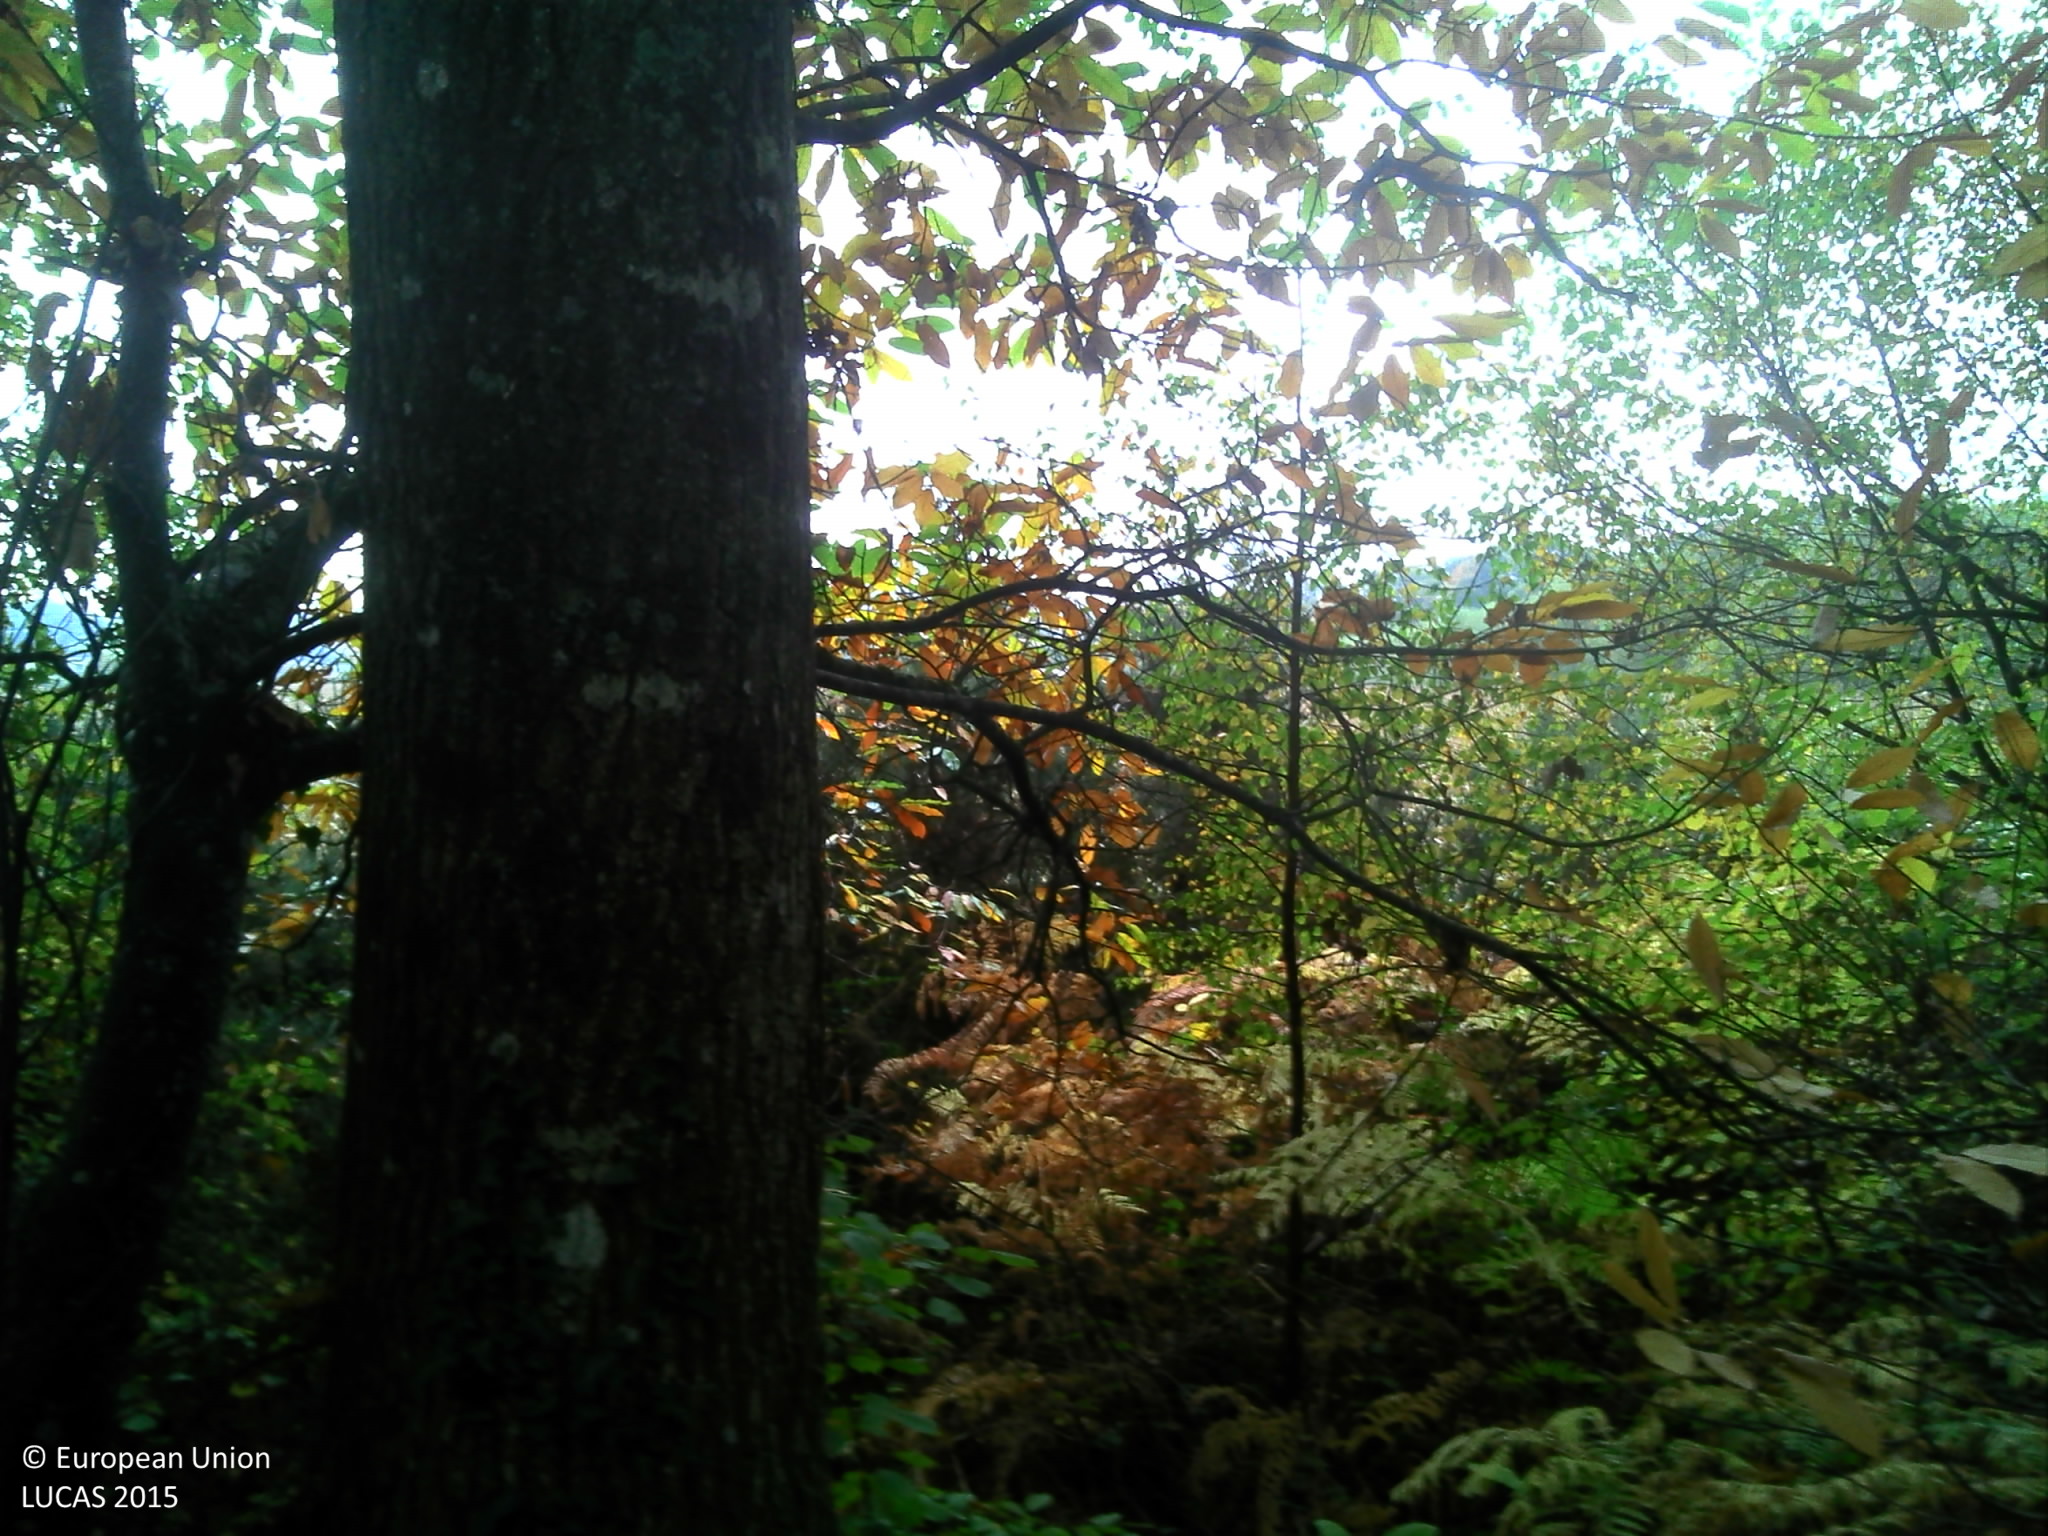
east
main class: Woodland
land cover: Broadleaved woodland
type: acidophilous oak and oak-birch forest
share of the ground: > 75 %
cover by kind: broadleaved forest trees 100 %
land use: Forestry
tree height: > 5 m
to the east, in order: Broadleaved woodland; Tracks; Broadleaved woodland; Maize
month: November
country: FR
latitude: 48.1234
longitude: -3.0059
